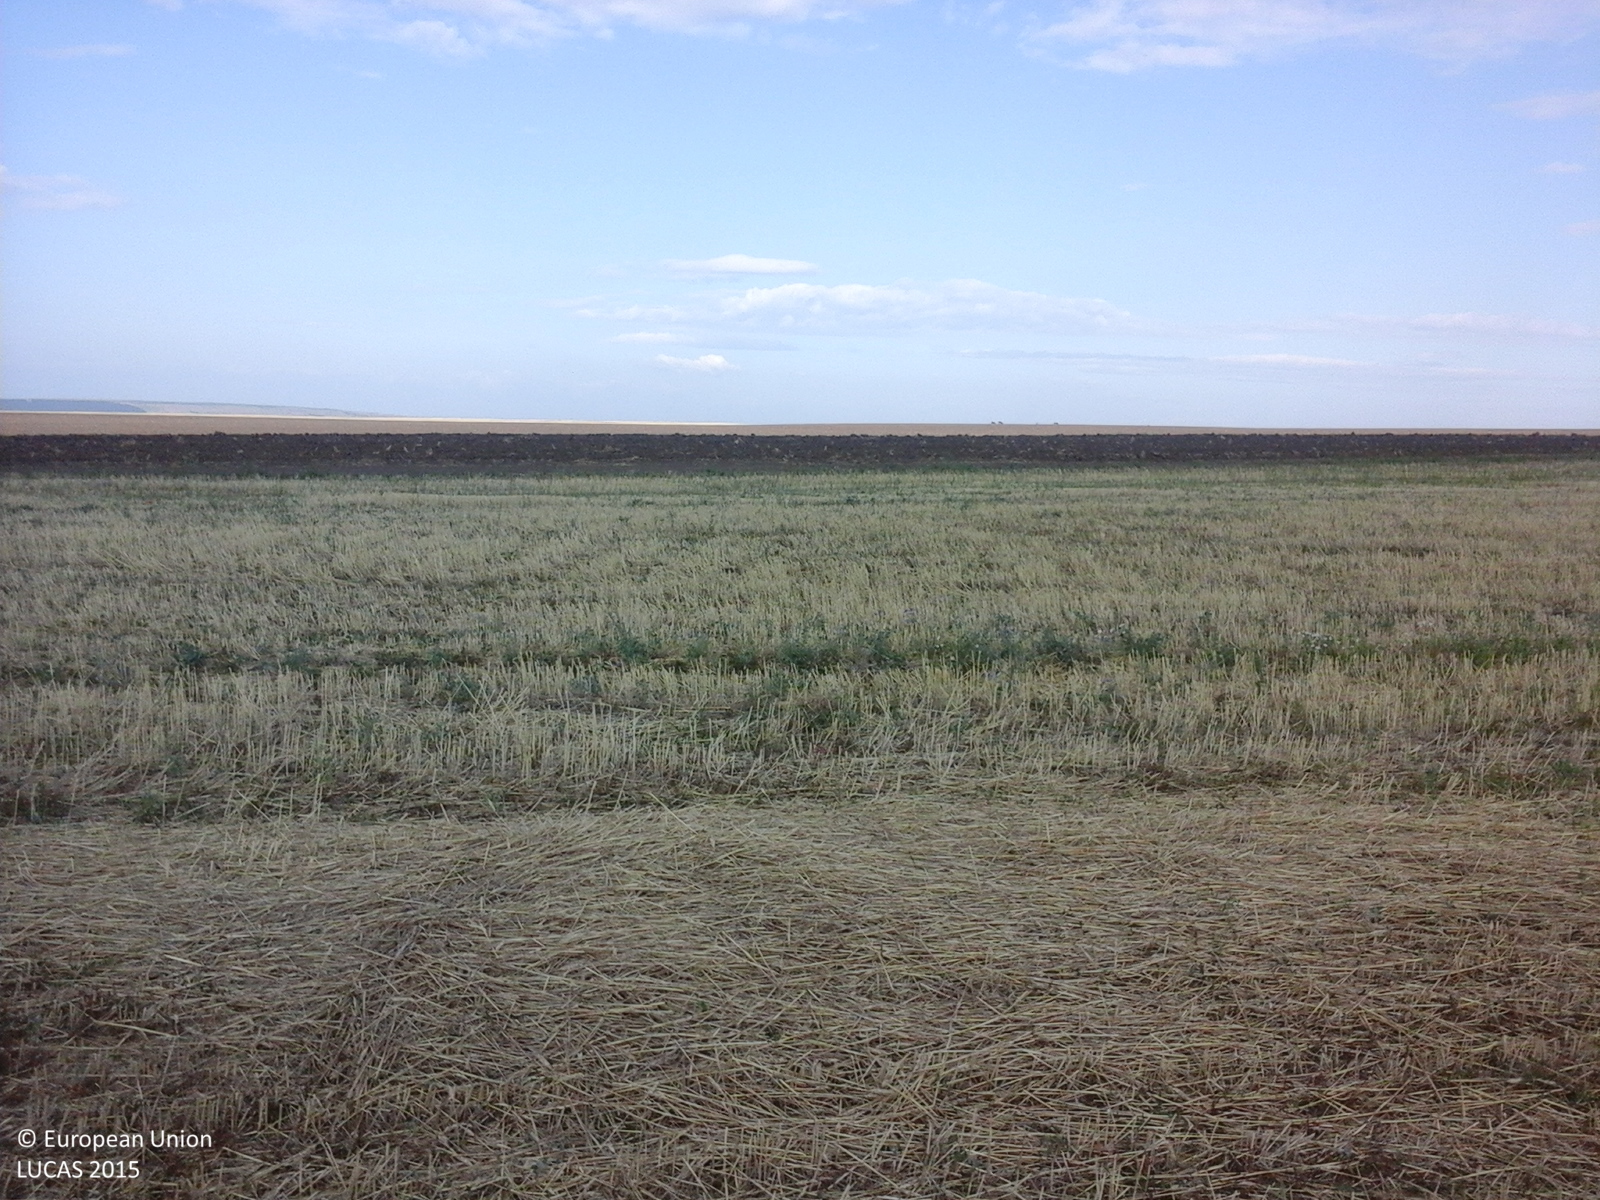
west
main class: Cropland
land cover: Sunflower
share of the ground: > 75 %
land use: Agriculture (excluding fallow land and kitchen gardens)
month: July
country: RO
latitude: 46.1350
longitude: 27.7850
